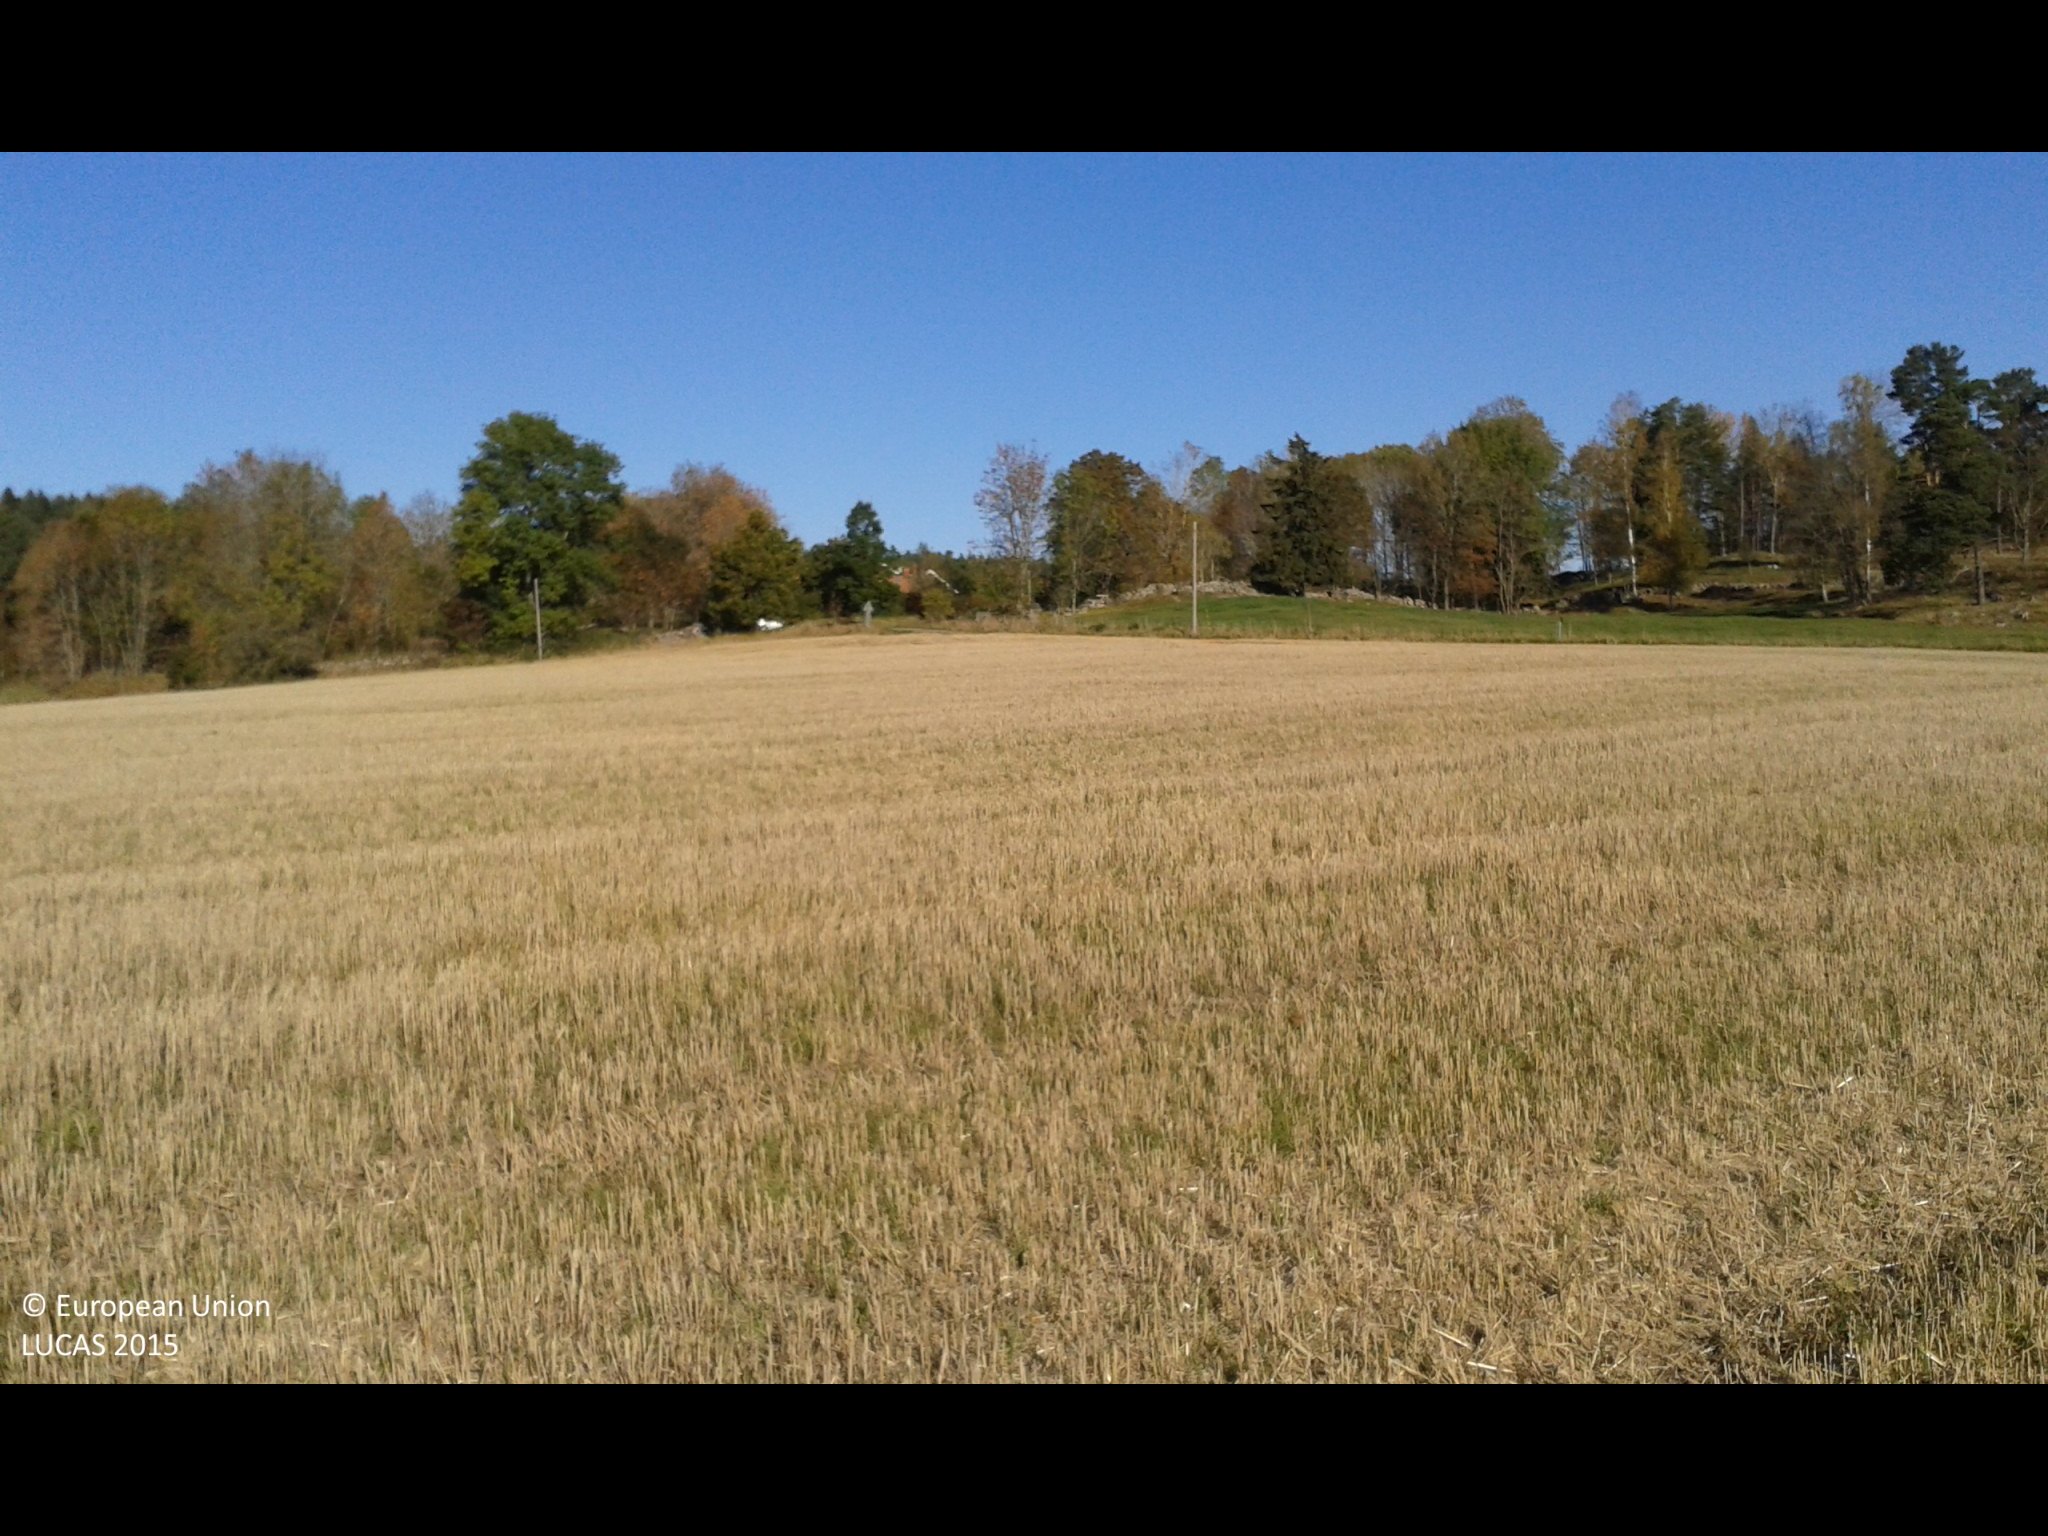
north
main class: Cropland
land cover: Barley
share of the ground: < 10 %
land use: Agriculture (excluding fallow land and kitchen gardens)
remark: Harvested field
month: October
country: SE
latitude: 58.8545
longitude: 17.2603
